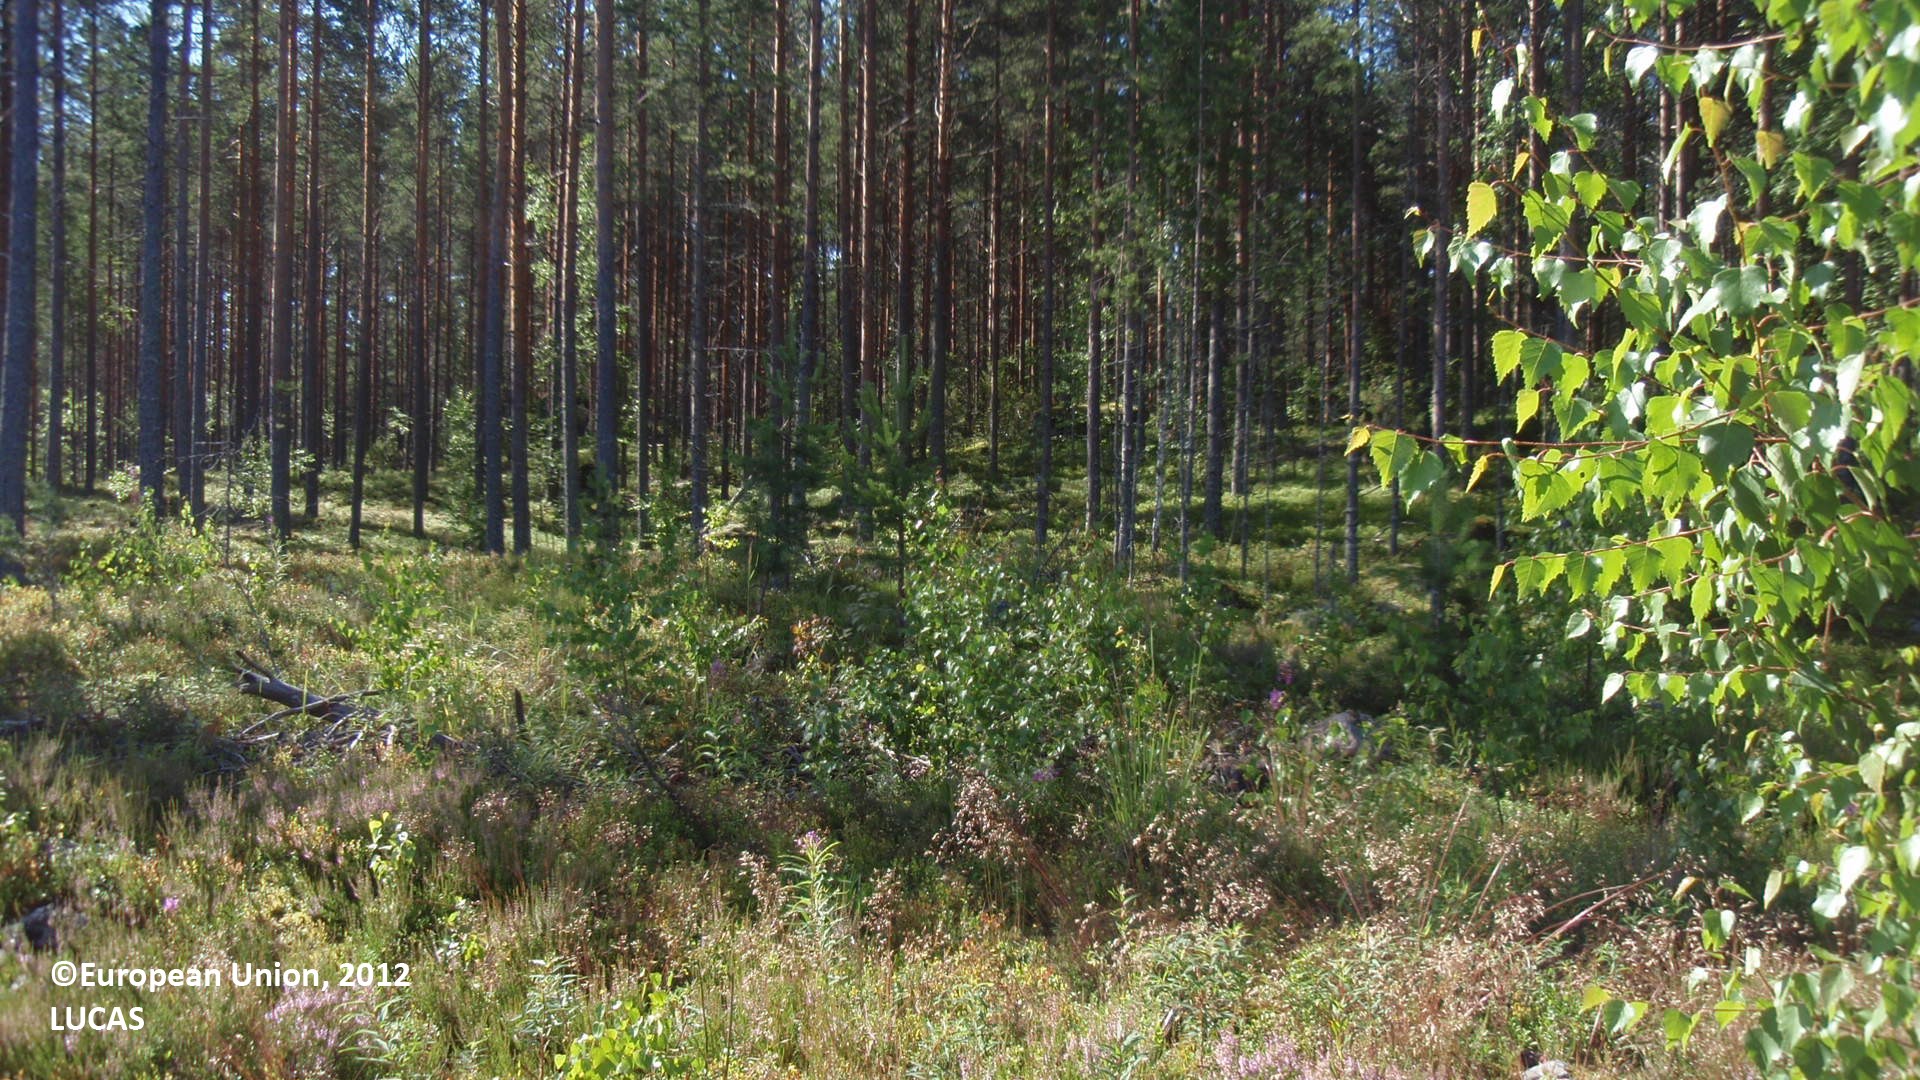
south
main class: Grassland
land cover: Grassland with sparse tree/shrub cover
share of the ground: > 75 %
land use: Forestry
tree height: > 5 m
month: July
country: FI
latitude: 61.4212
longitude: 28.1332
